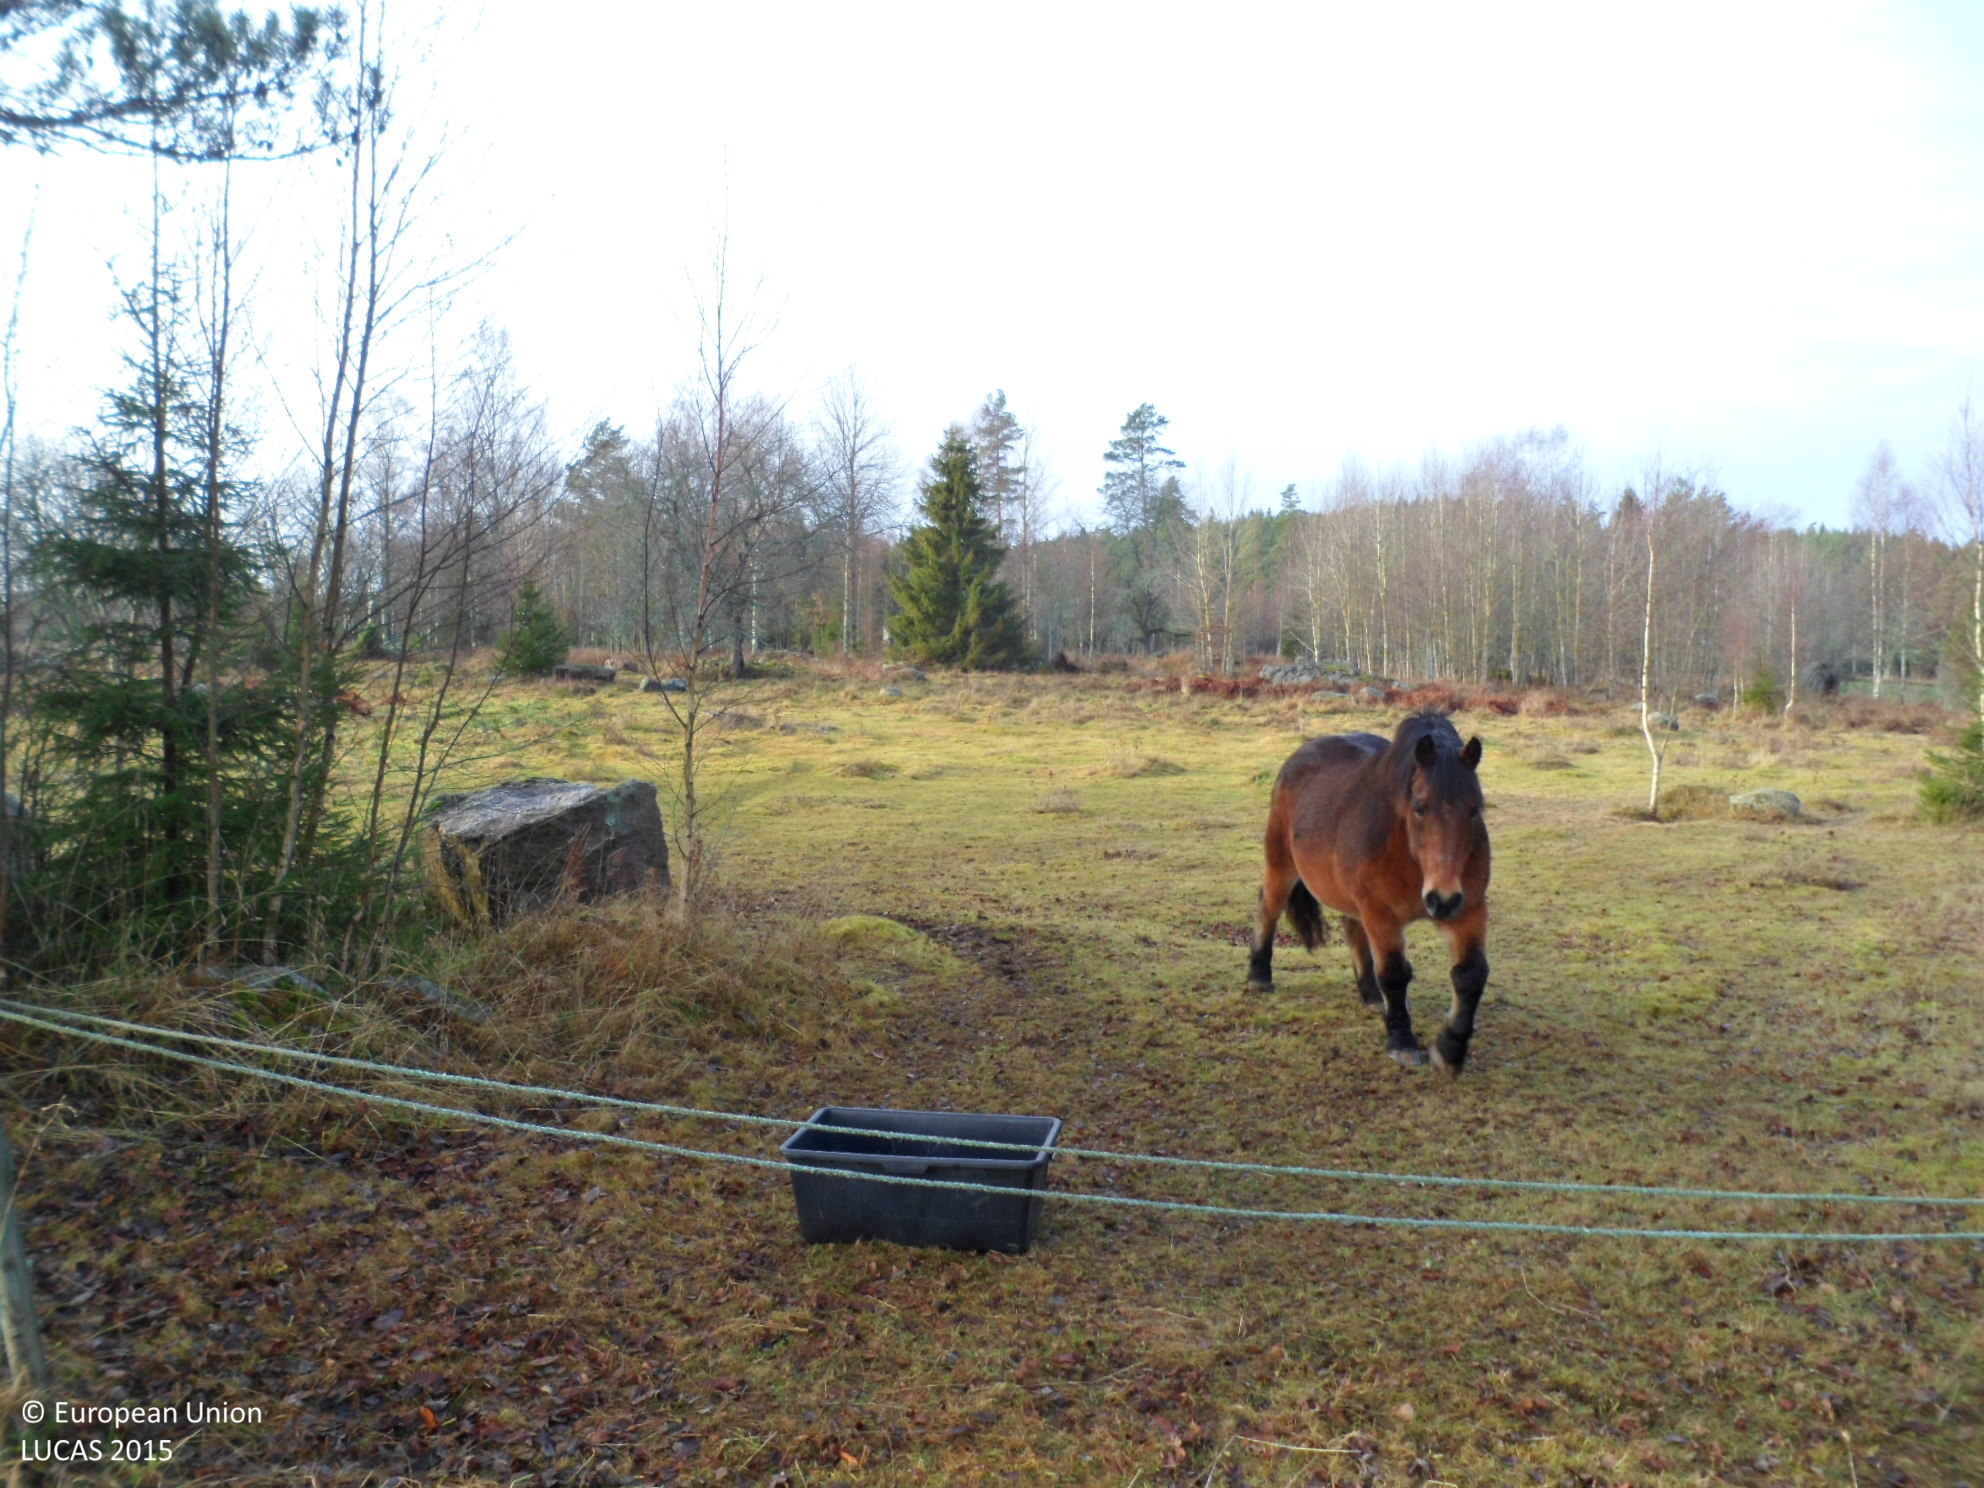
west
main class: Woodland
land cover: Broadleaved woodland
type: hemiboreal forest and nemoral coniferous forest and mixed broadleaved-coniferous forest
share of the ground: 10 - 25 %
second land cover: Grassland without tree/shrub cover
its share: > 75 %
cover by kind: herbaceous plants 55 %, broadleaved forest trees 20 %, shrubs 15 %, coniferous forest trees 5 %, lichens and mosses 5 %
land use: Forestry
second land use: Agriculture (excluding fallow land and kitchen gardens)
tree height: > 5 m
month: November
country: SE
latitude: 57.7468
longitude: 15.4900
